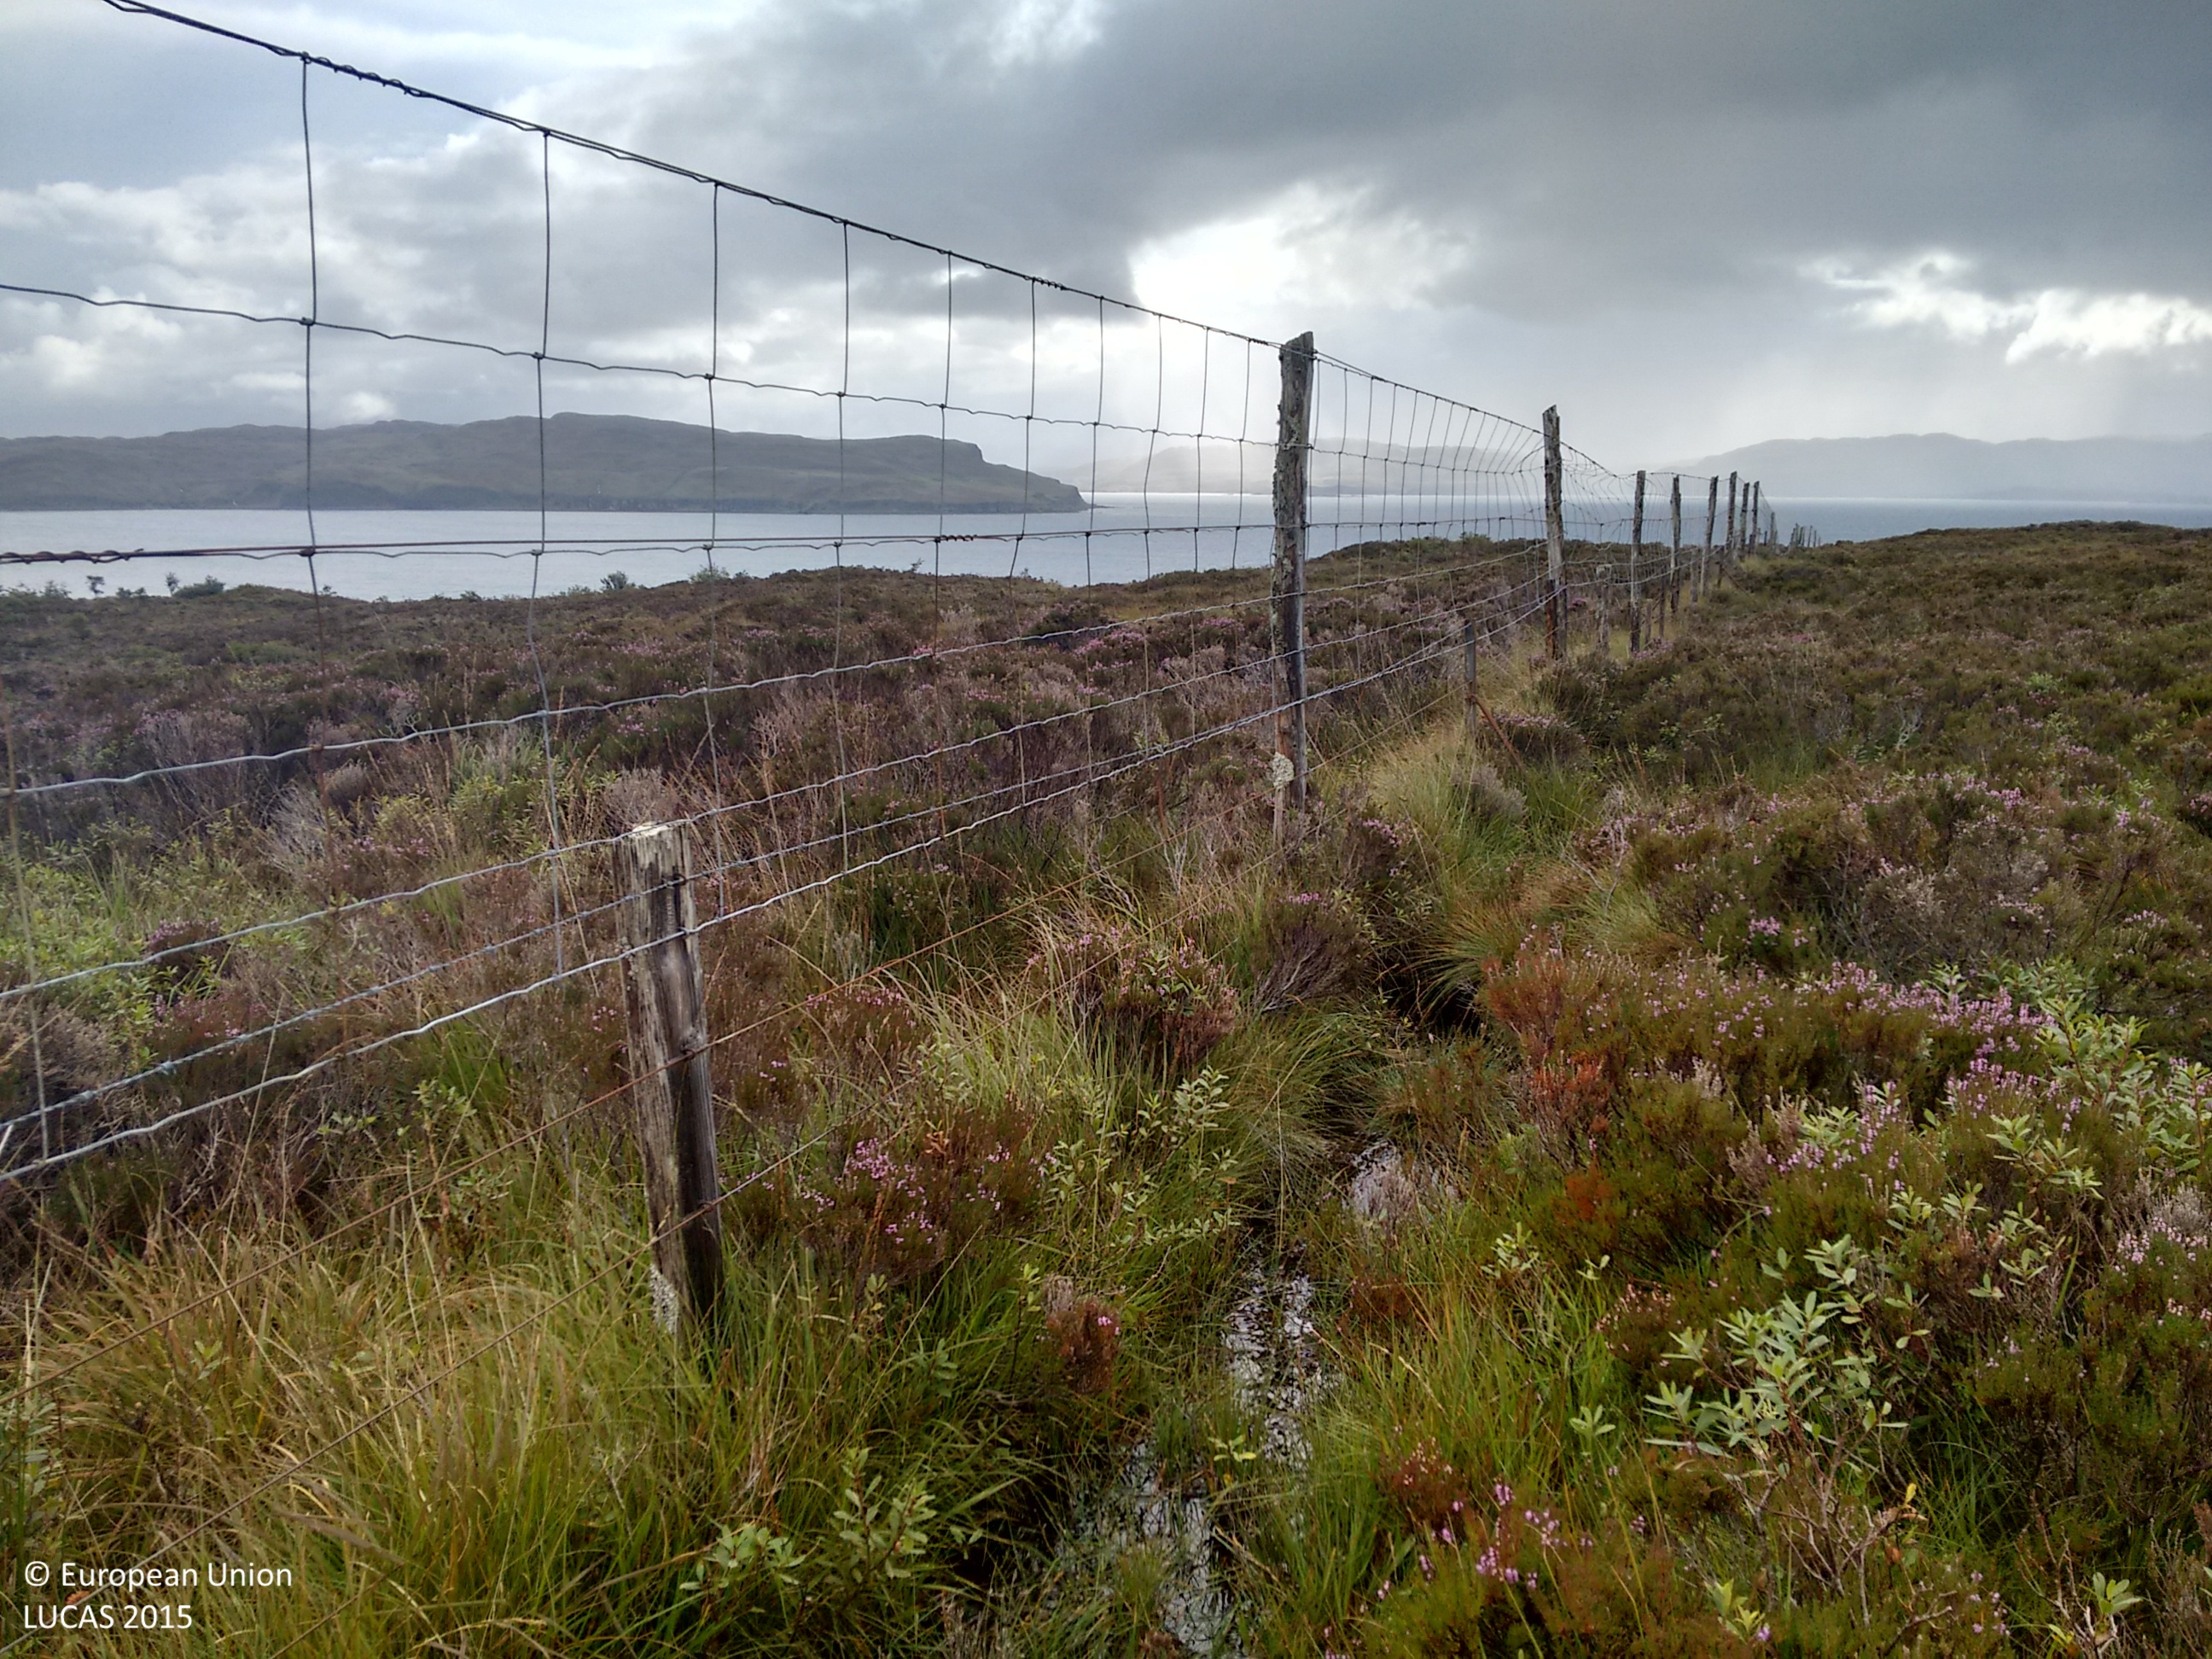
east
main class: Shrubland
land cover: Shrubland without tree cover
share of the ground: > 75 %
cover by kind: shrubs 100 %
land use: Semi-natural and natural areas not in use
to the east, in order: Shrubland without tree cover; Broadleaved woodland; Shrubland with sparse tree cover; Rivers and streams; Shrubland with sparse tree cover; Shrubland without tree cover; Broadleaved woodland; Ditches and canals; Broadleaved woodland; Ditches and canals; Broadleaved woodland
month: September
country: GB
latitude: 57.1705
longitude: -6.0583
